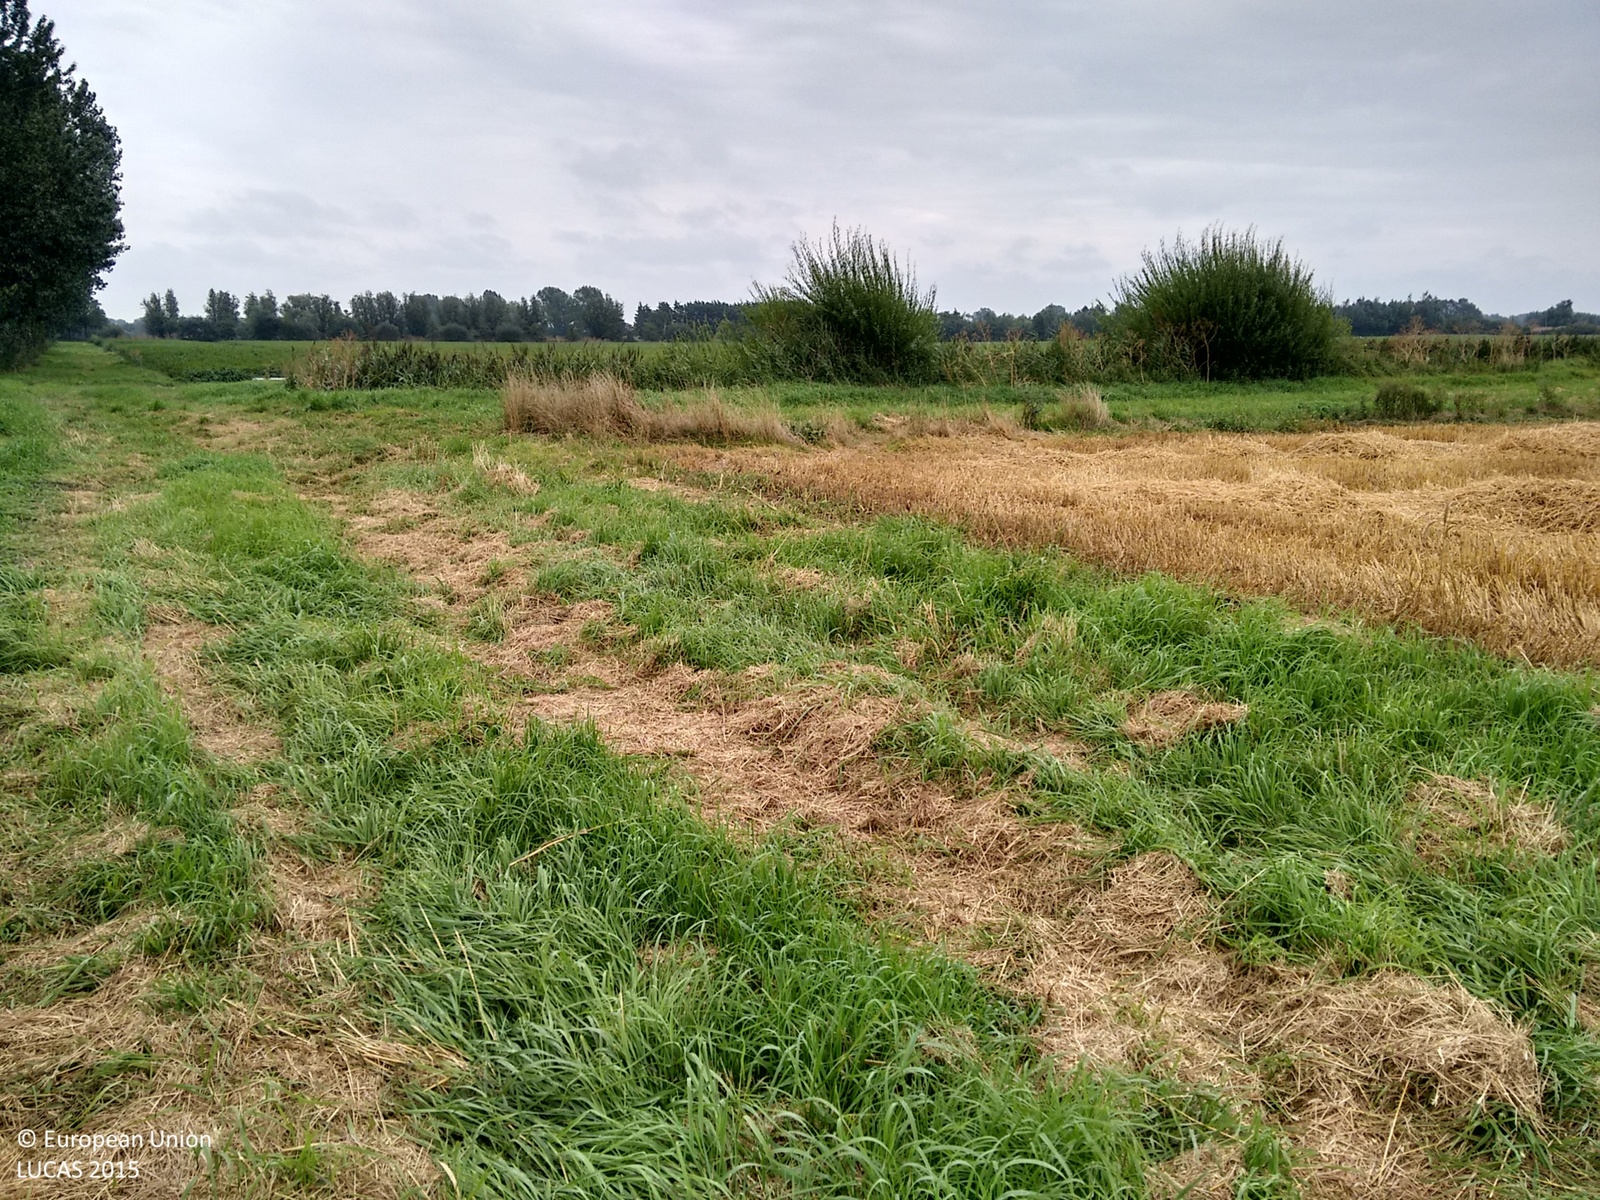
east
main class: Grassland
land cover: Grassland without tree/shrub cover
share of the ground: > 75 %
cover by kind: herbaceous plants 100 %
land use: Agriculture (excluding fallow land and kitchen gardens)
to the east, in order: Grassland without tree/shrub cover; Tracks; Grass margins; Ditches and canals; Grass margins; Other bare soil; Potatoes
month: August
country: GB
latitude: 52.3841
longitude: 0.3773
